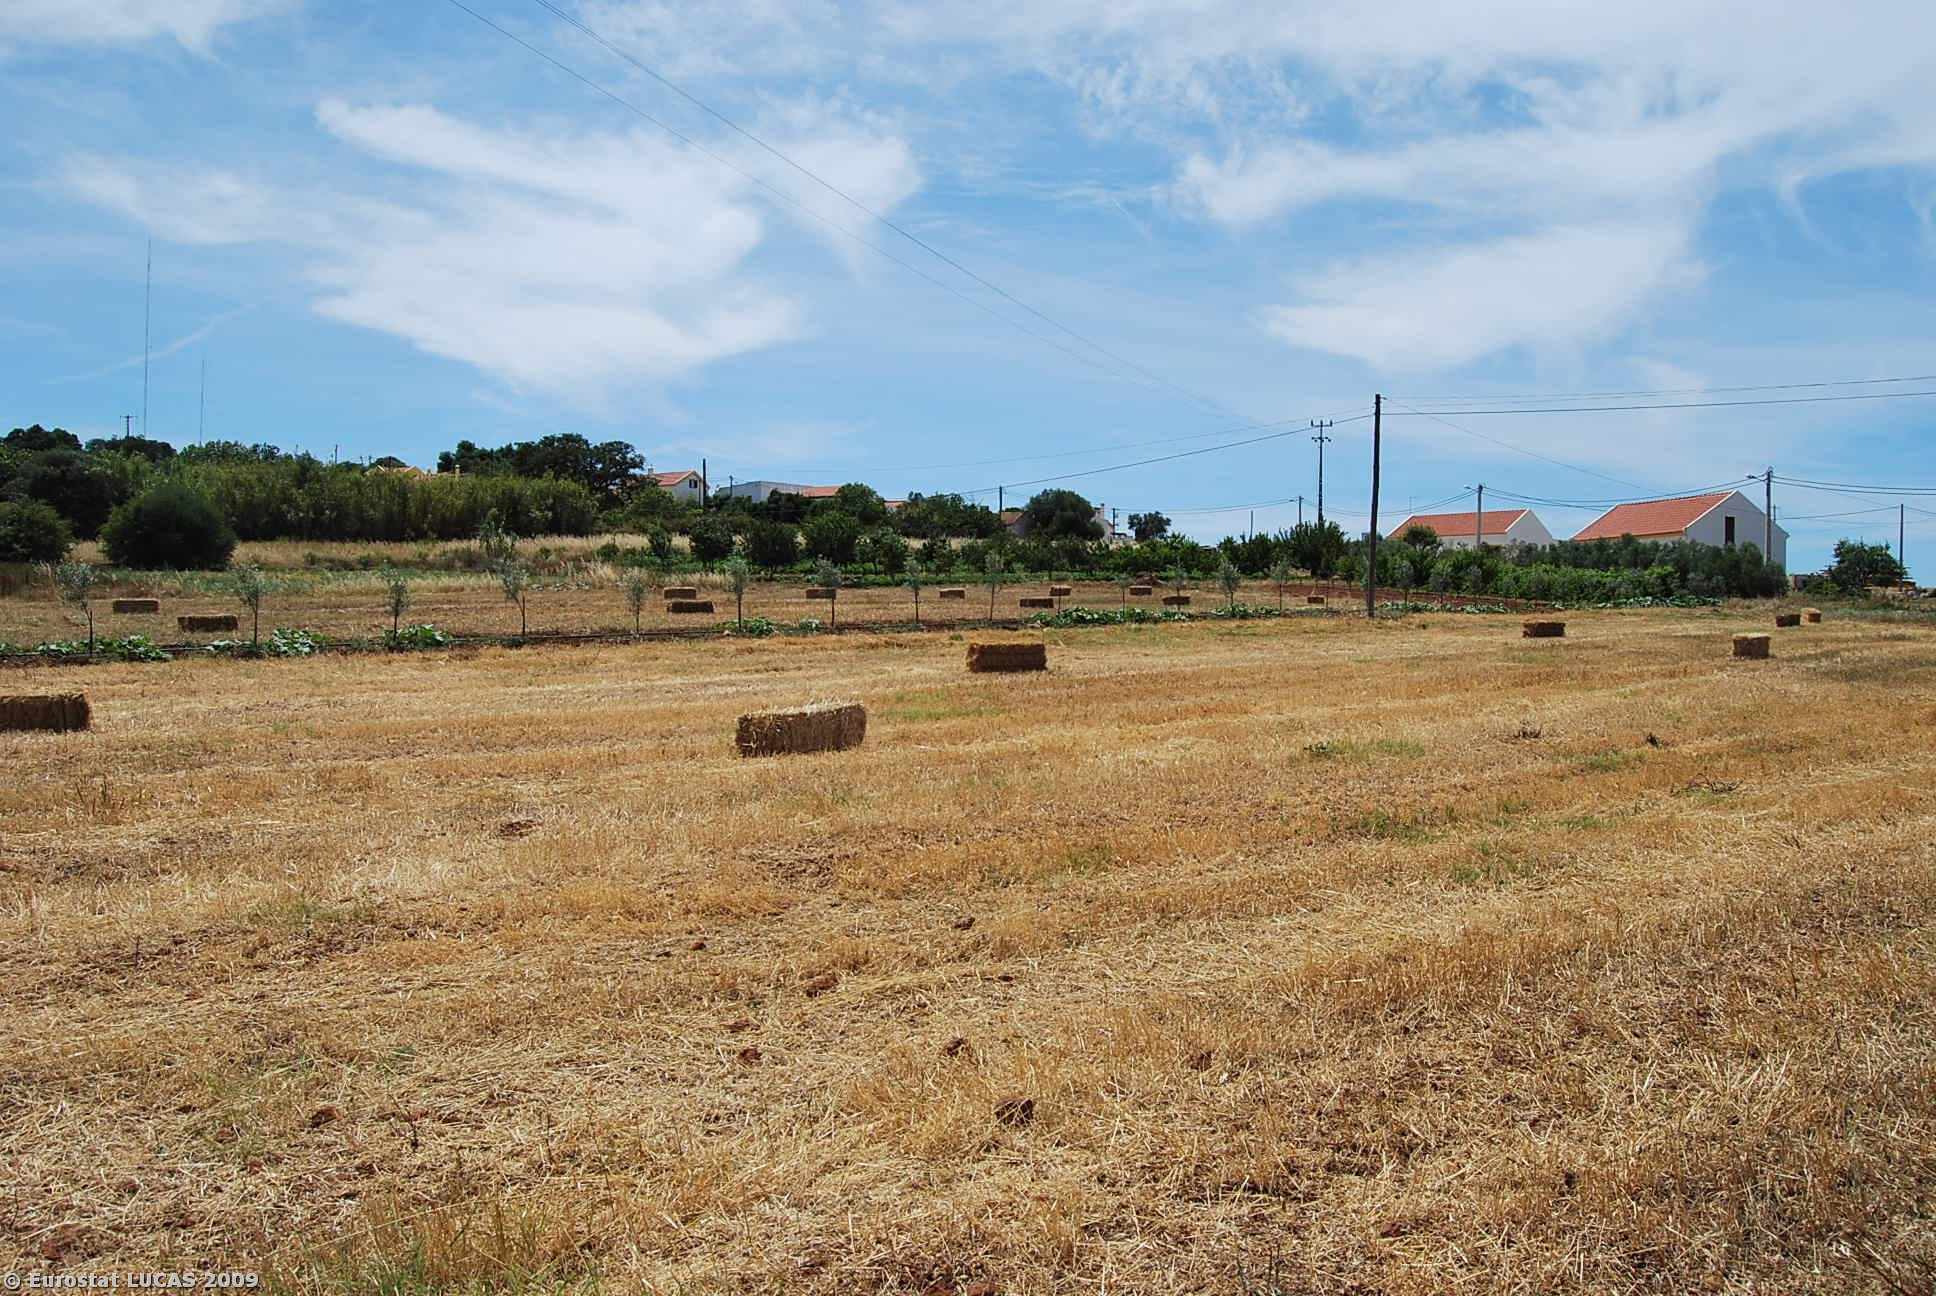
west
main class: Cropland
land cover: Potatoes
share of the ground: 50 - 75 %
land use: Agriculture (excluding fallow land and kitchen gardens)
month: June
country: PT
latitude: 37.9906
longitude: -8.6874
